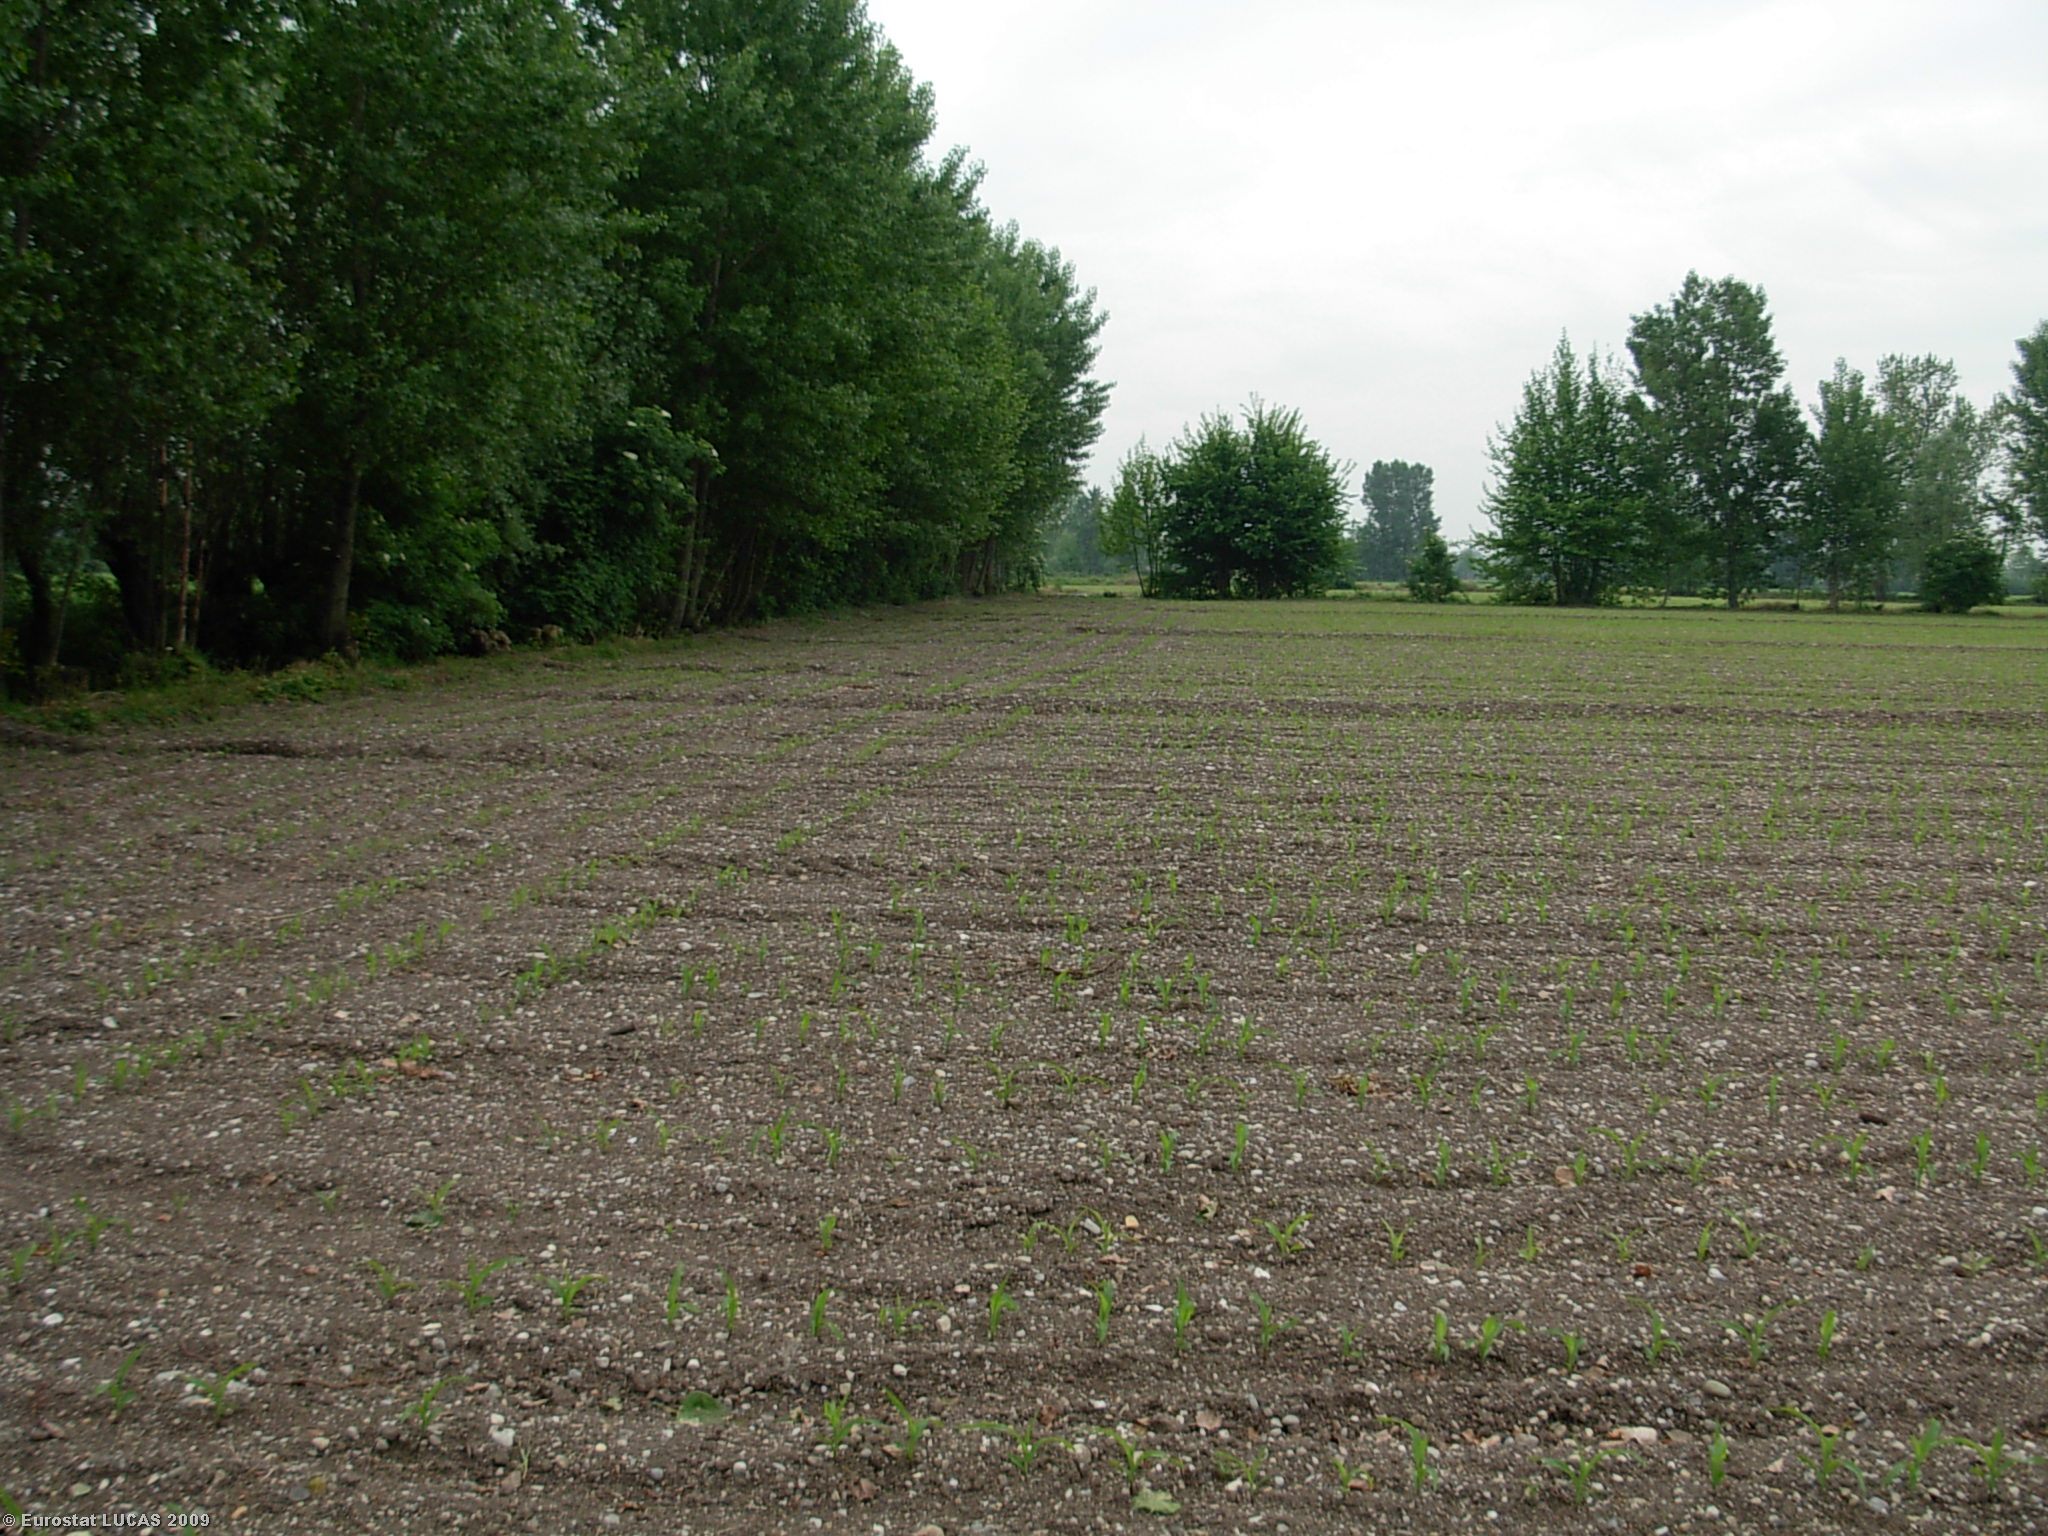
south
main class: Cropland
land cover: Maize
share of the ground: < 10 %
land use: Agriculture (excluding fallow land and kitchen gardens)
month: May
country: IT
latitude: 45.3417
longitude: 10.3185
